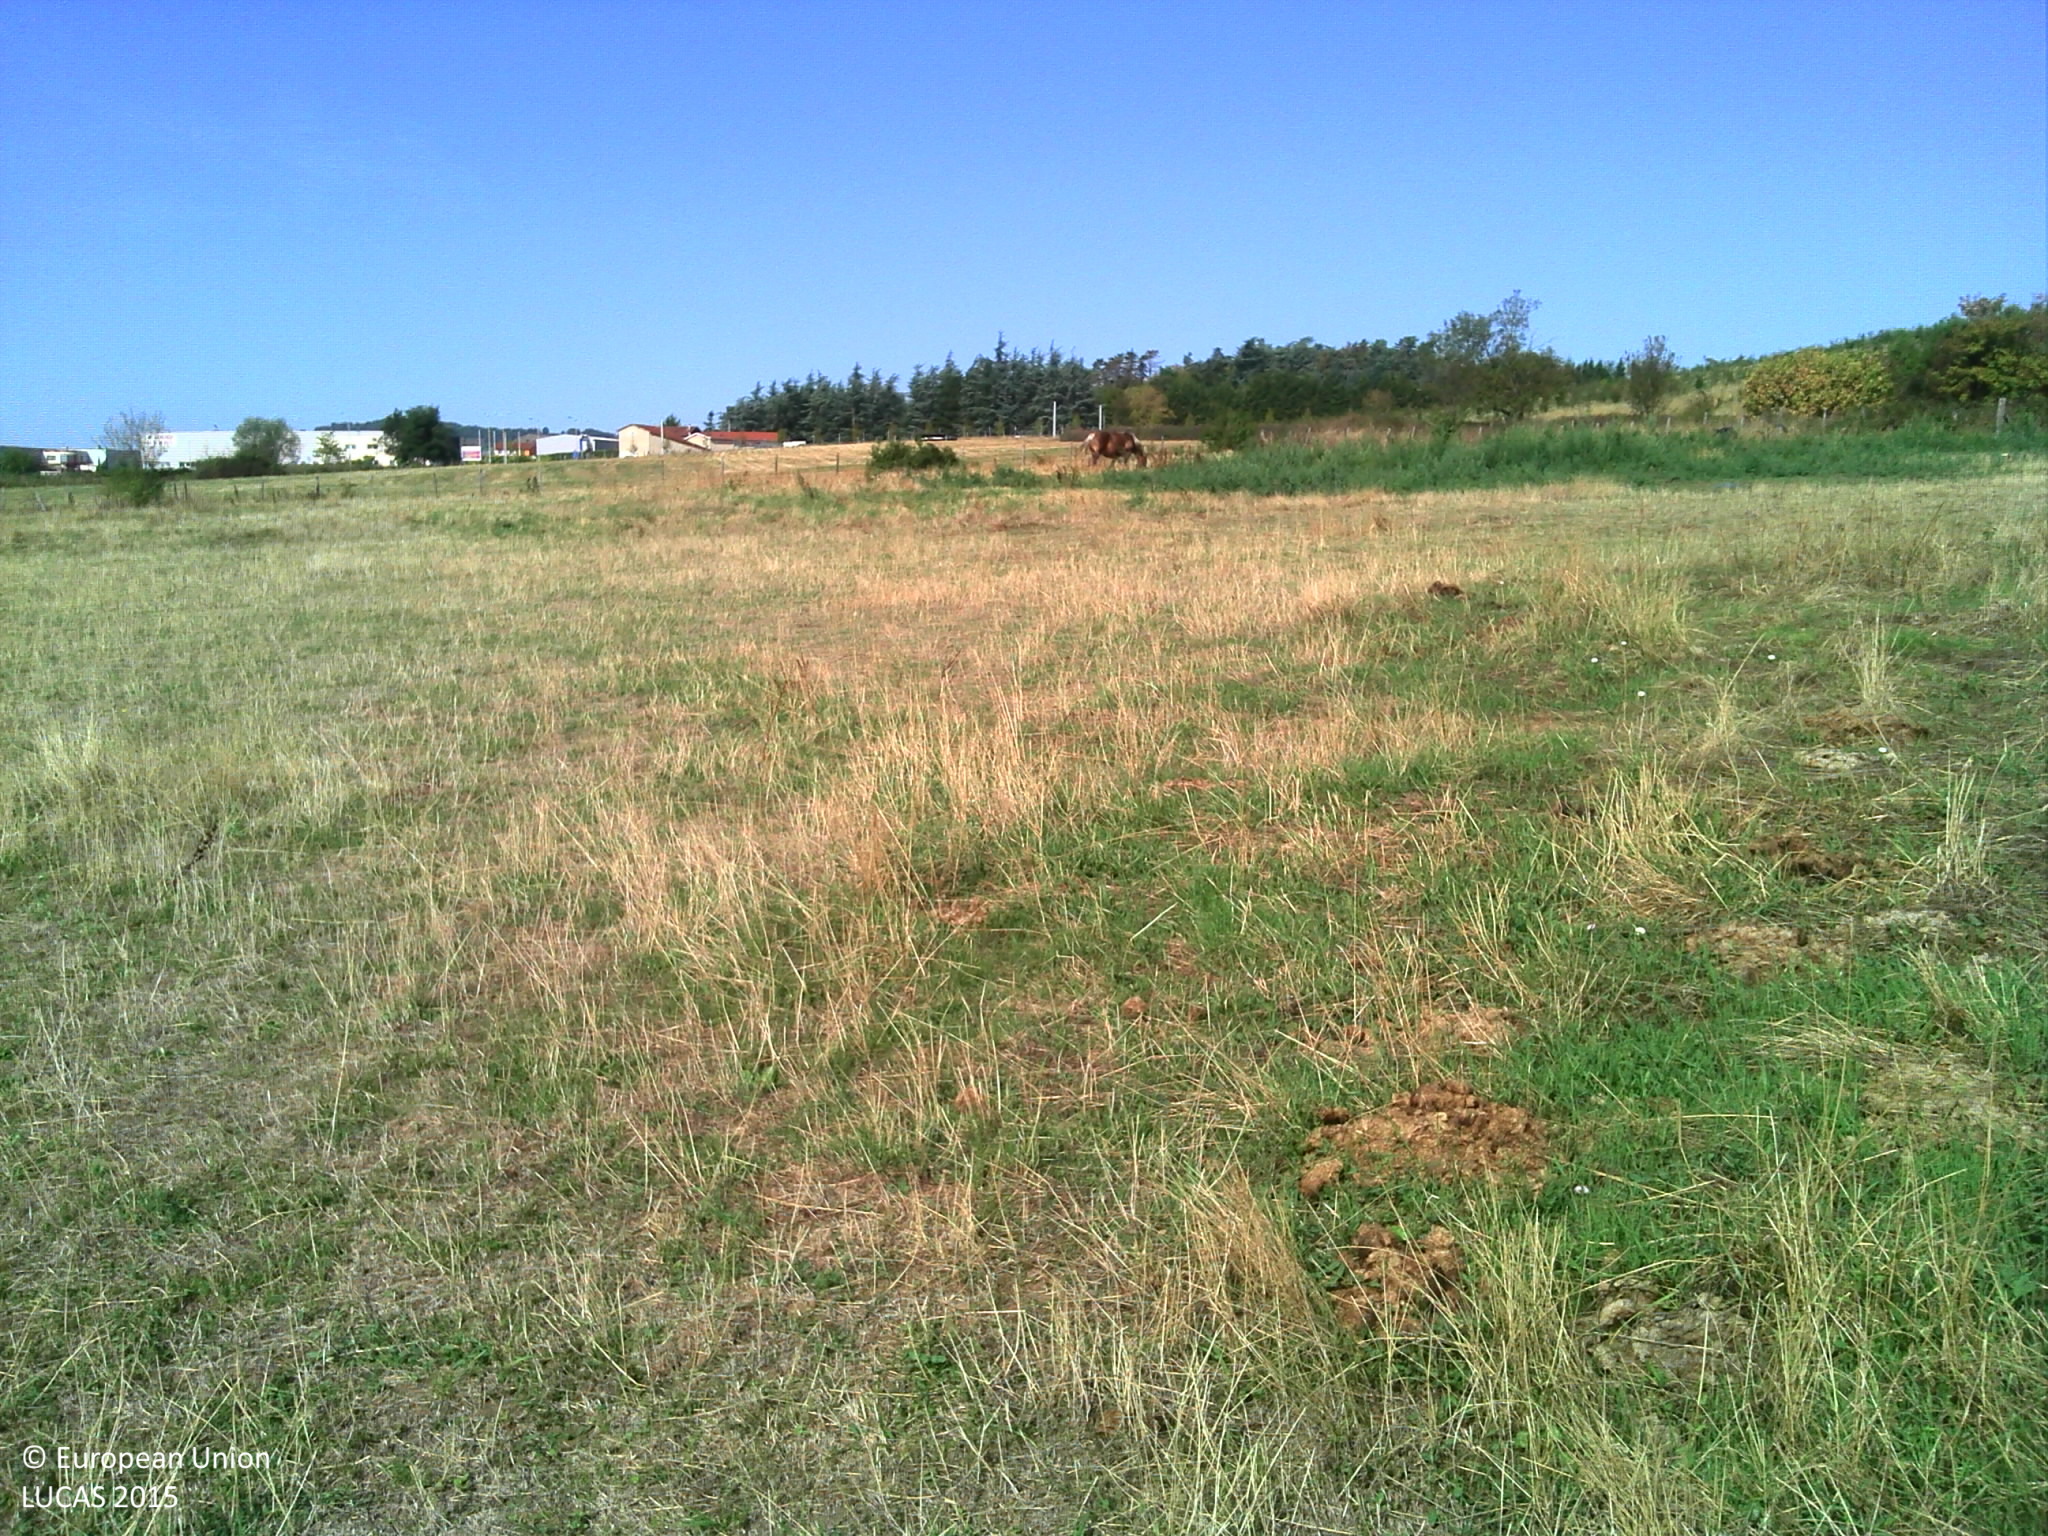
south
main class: Grassland
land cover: Grassland without tree/shrub cover
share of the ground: > 75 %
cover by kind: herbaceous plants 100 %
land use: Agriculture (excluding fallow land and kitchen gardens)
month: August
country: FR
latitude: 45.8221
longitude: 4.6874
